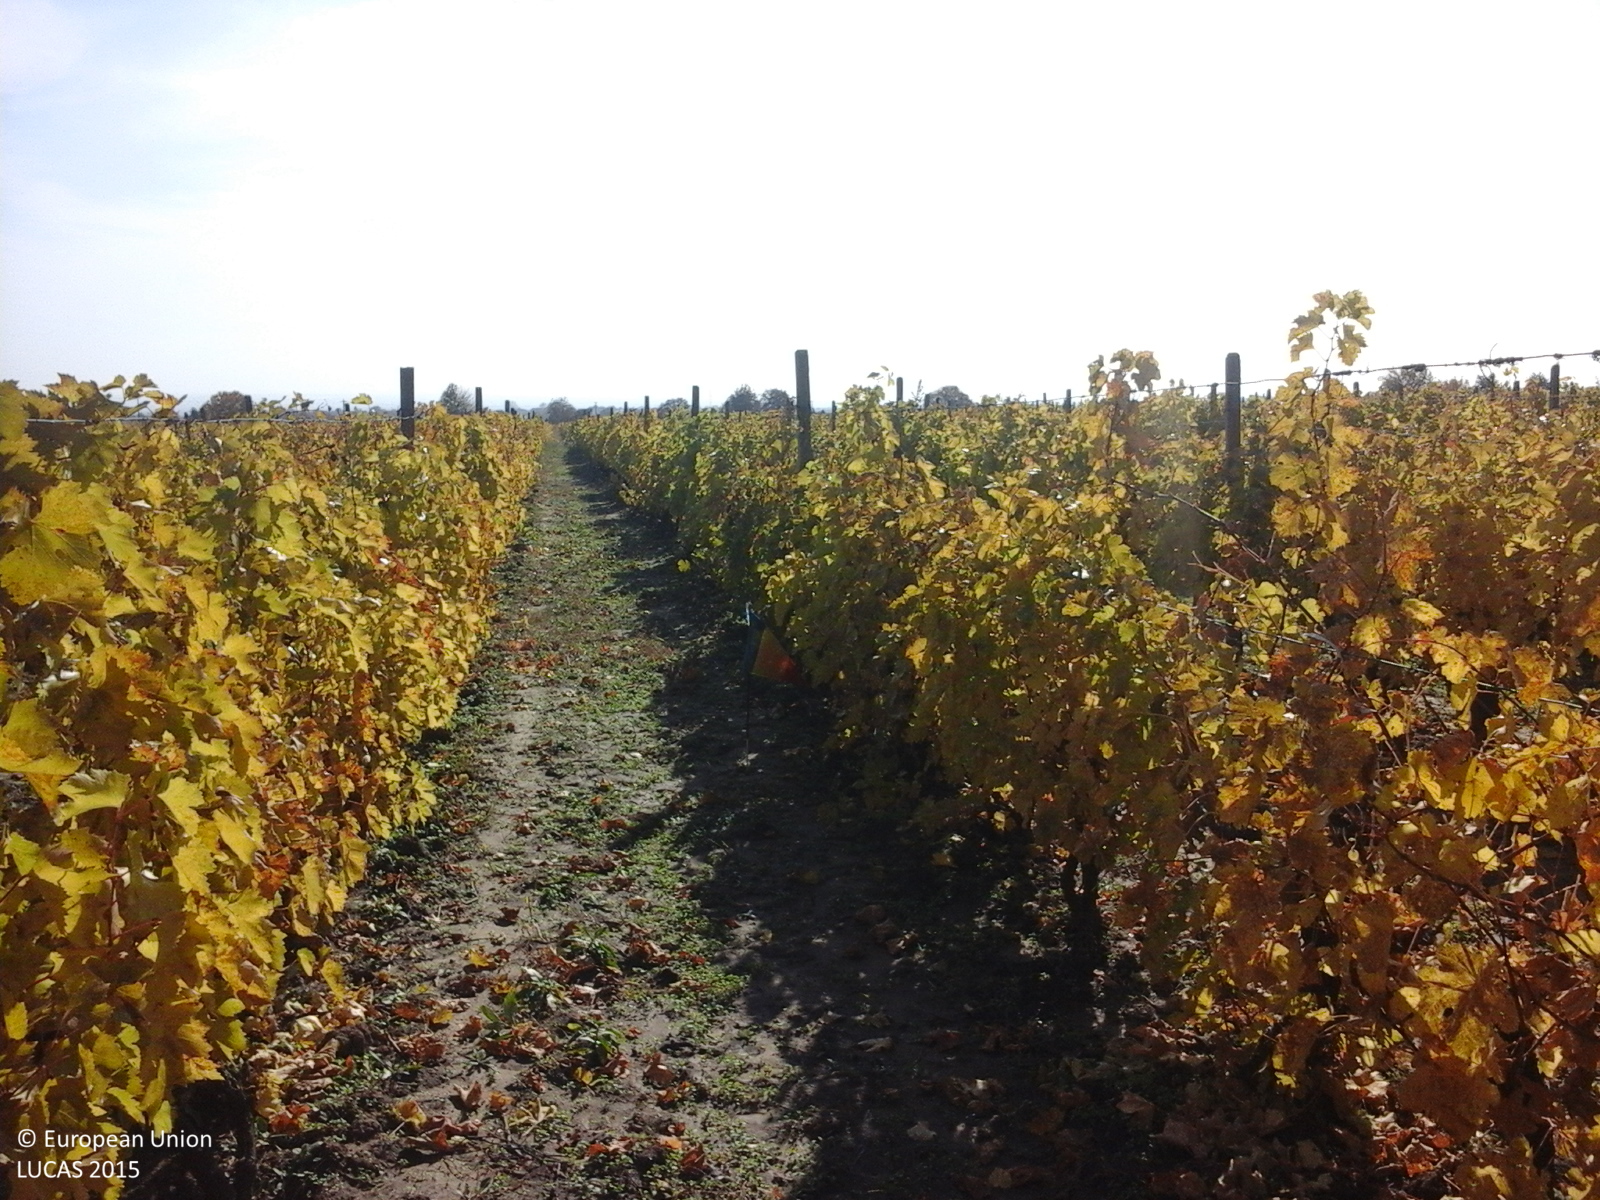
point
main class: Cropland
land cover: Vineyards
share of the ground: > 75 %
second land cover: Grassland without tree/shrub cover
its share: 25 - 50 %
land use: Agriculture (excluding fallow land and kitchen gardens)
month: October
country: RO
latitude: 45.9740
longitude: 27.0922
